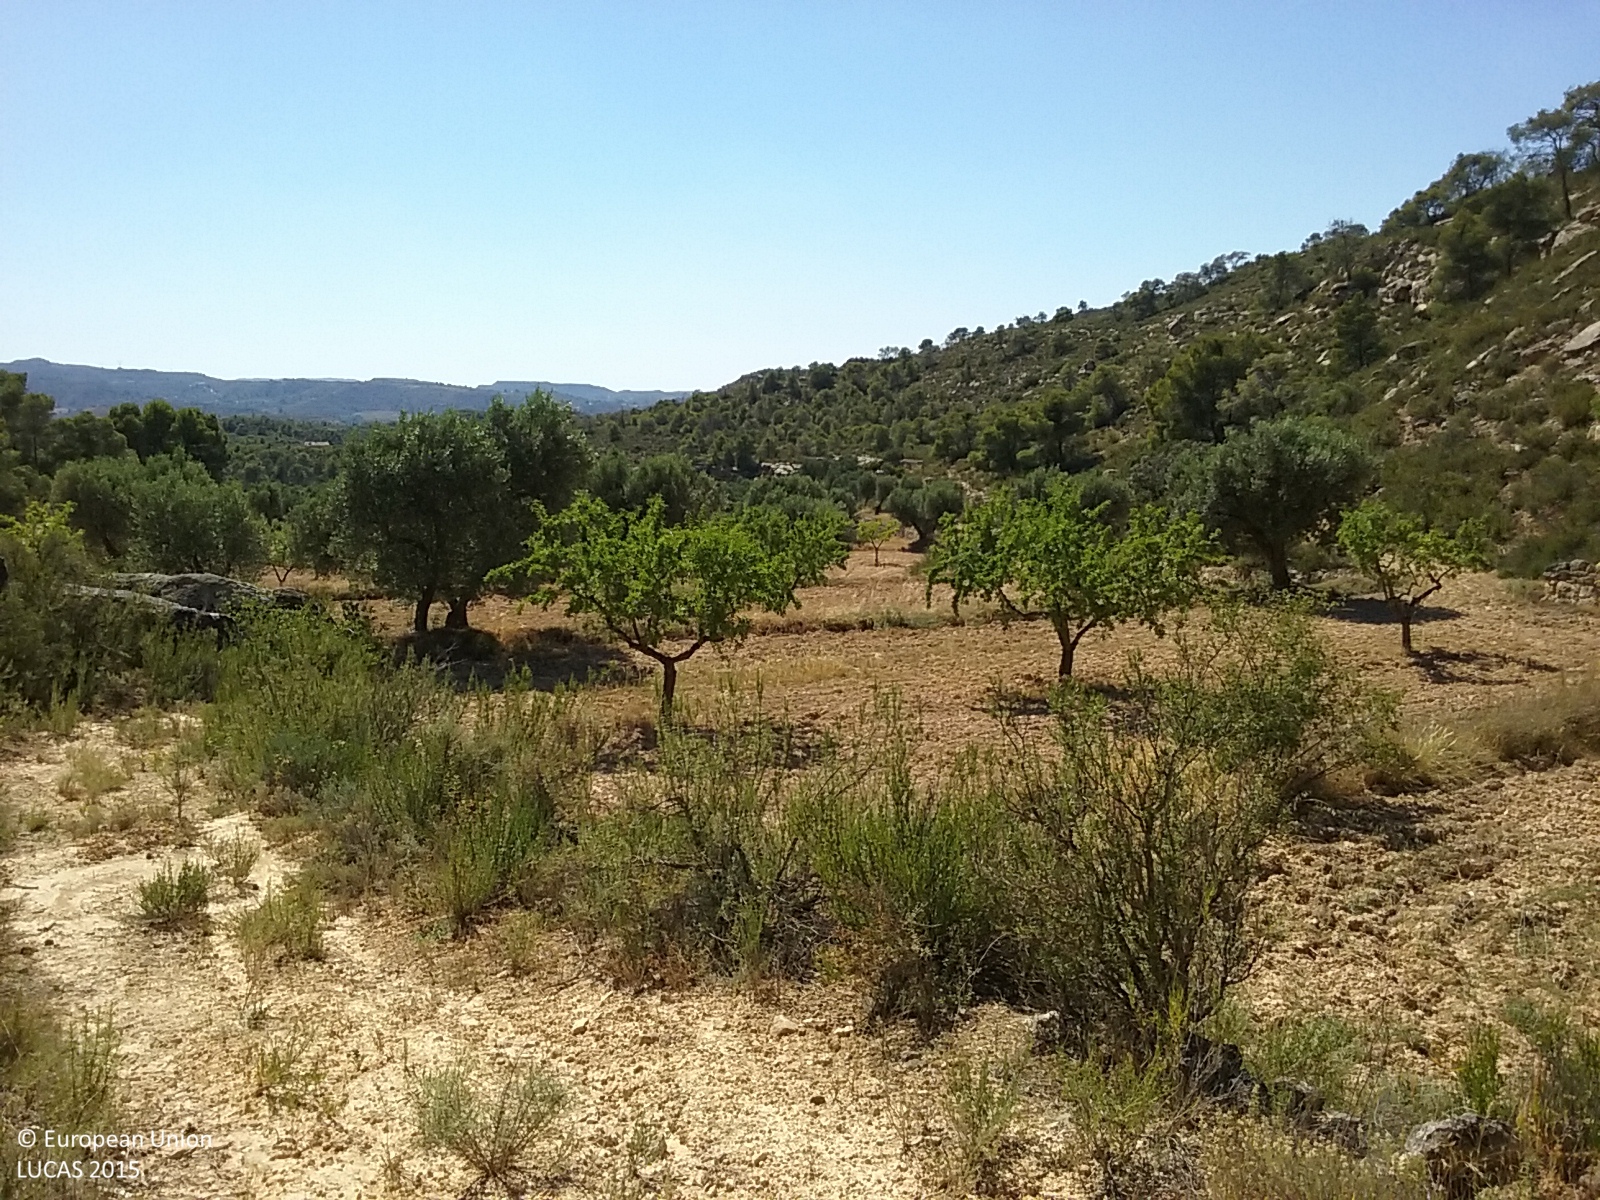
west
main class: Woodland
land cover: Pine dominated coniferous woodland
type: coniferous forest of the mediterranean region
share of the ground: 50 - 75 %
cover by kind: coniferous forest trees 70 %, shrubs 30 %
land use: Semi-natural and natural areas not in use
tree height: > 5 m
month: June
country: ES
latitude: 41.1262
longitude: 0.2346
